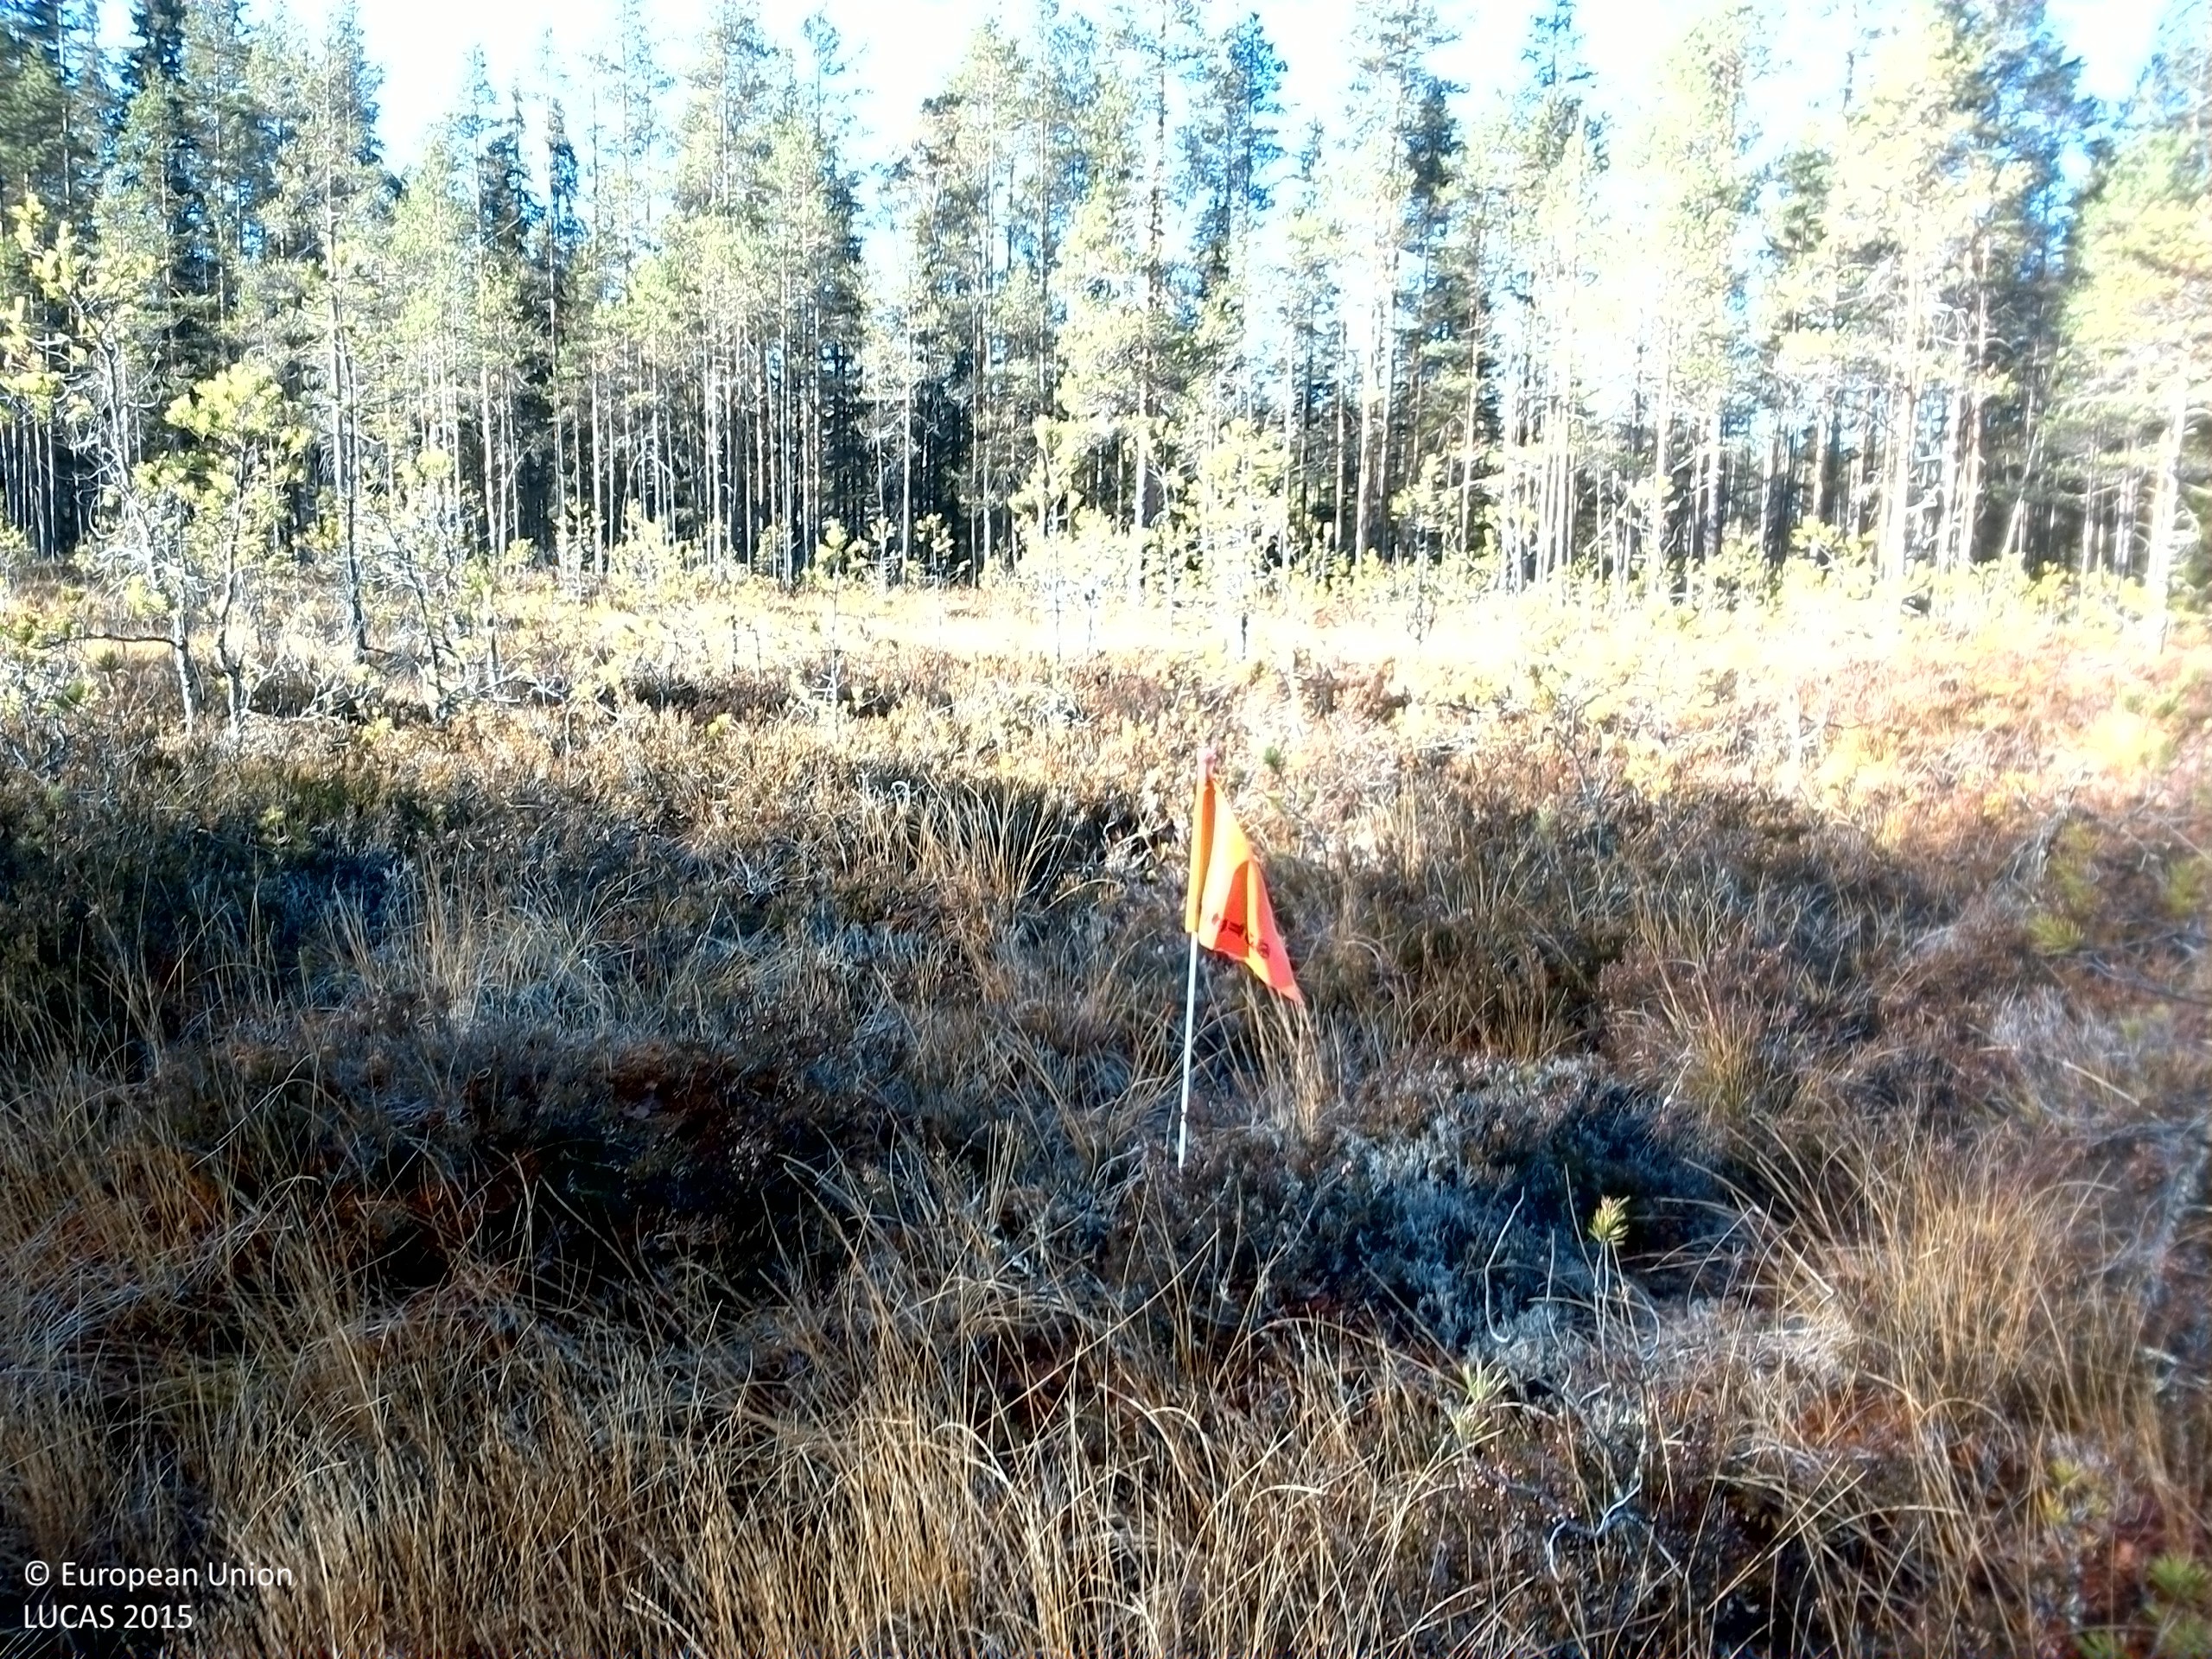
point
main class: Woodland
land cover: Pine dominated coniferous woodland
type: boreal forest
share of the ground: 10 - 25 %
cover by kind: lichens and mosses 40 %, shrubs 25 %, coniferous forest trees 20 %, herbaceous plants 15 %
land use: Semi-natural and natural areas not in use
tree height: < 5 m
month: October
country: SE
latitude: 61.1776
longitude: 14.3561
